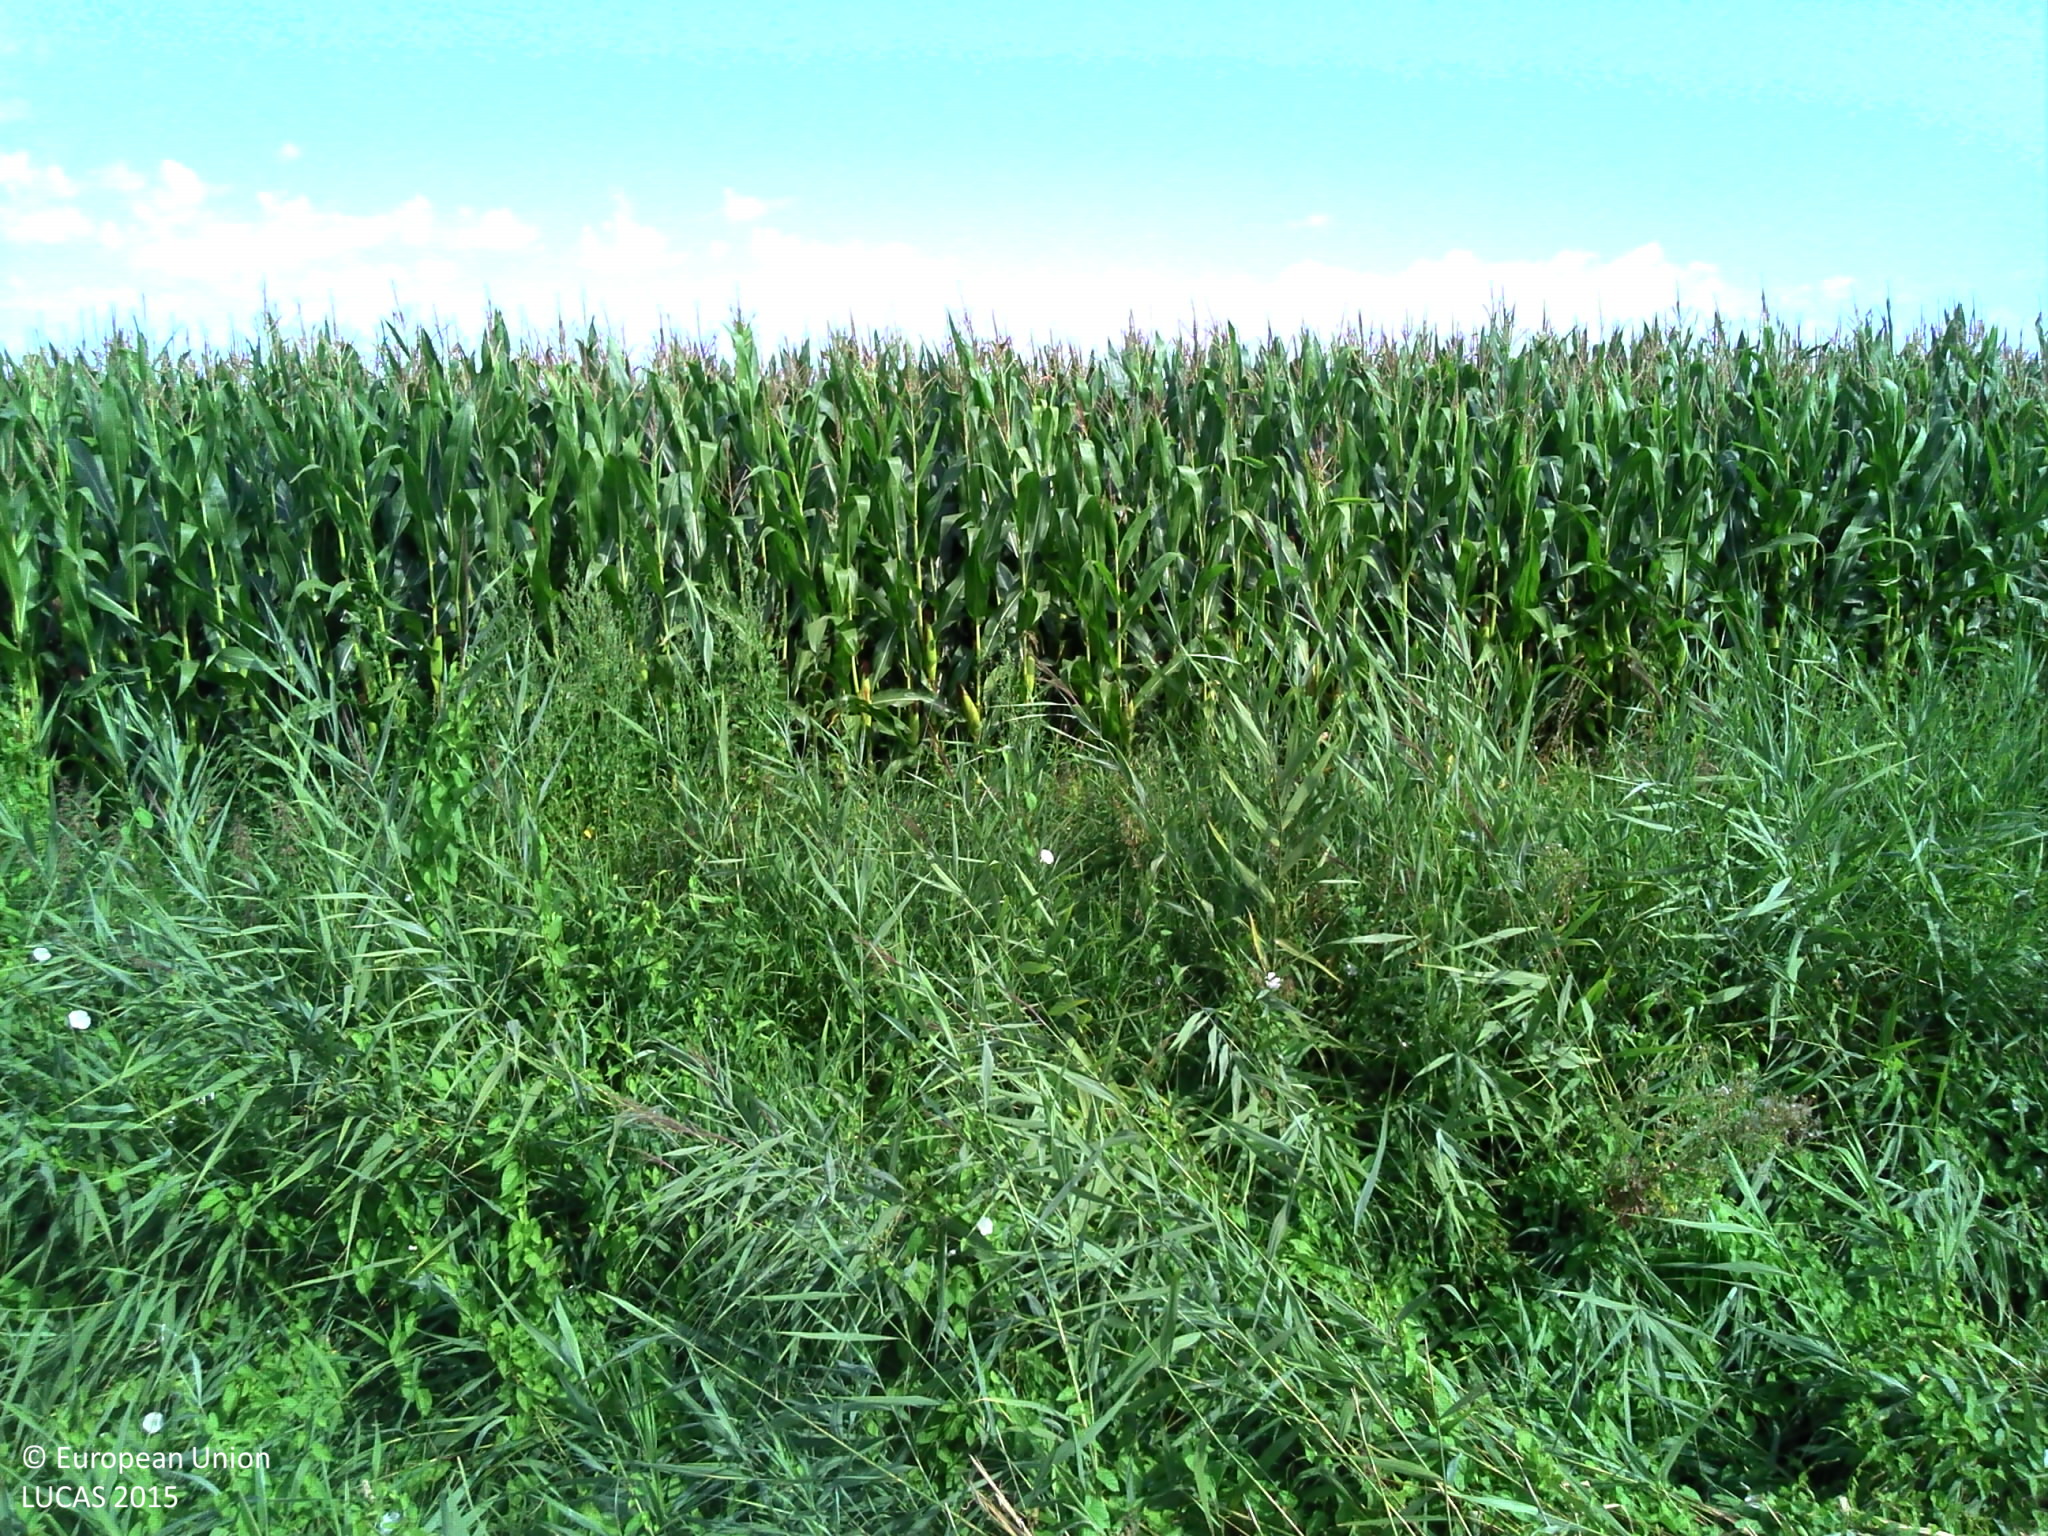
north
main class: Grassland
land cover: Grassland without tree/shrub cover
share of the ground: > 75 %
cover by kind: herbaceous plants 100 %
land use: Road transport
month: August
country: FR
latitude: 48.5619
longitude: -1.5246
